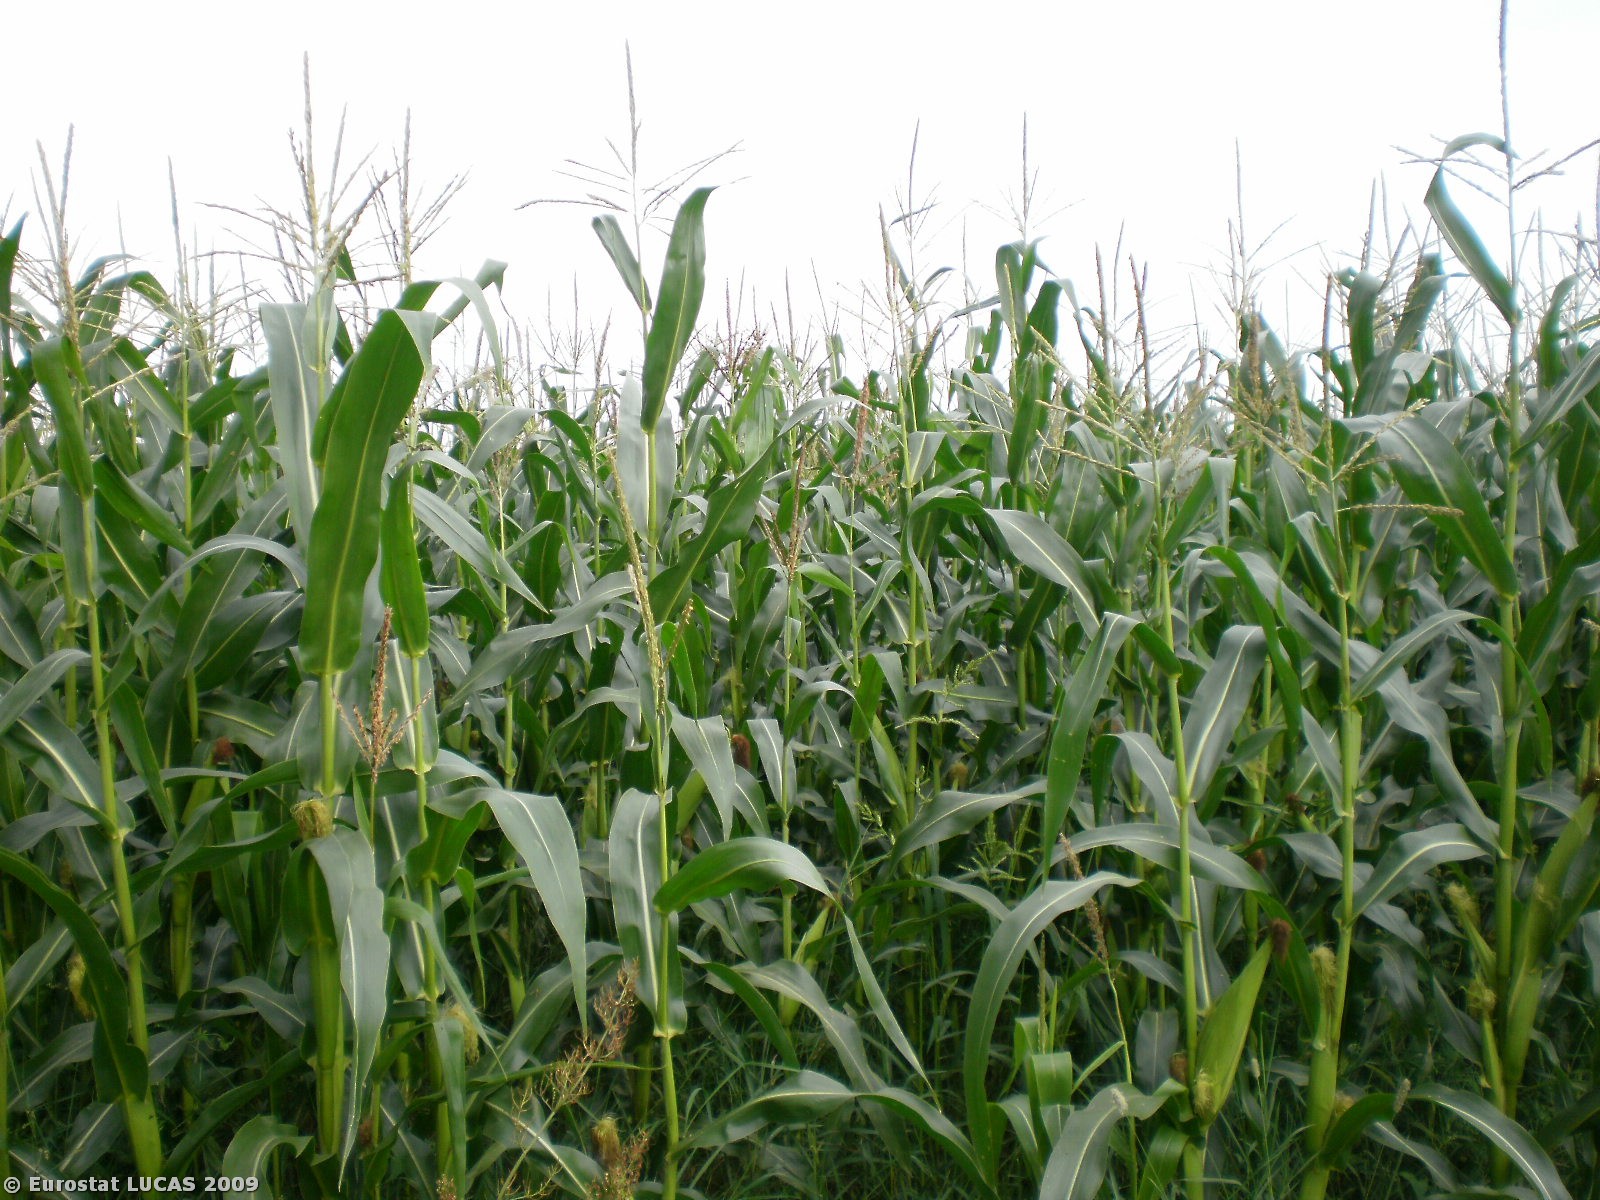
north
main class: Cropland
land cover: Maize
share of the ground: > 75 %
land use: Agriculture (excluding fallow land and kitchen gardens)
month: August
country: PL
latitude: 53.0179
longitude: 21.8469
